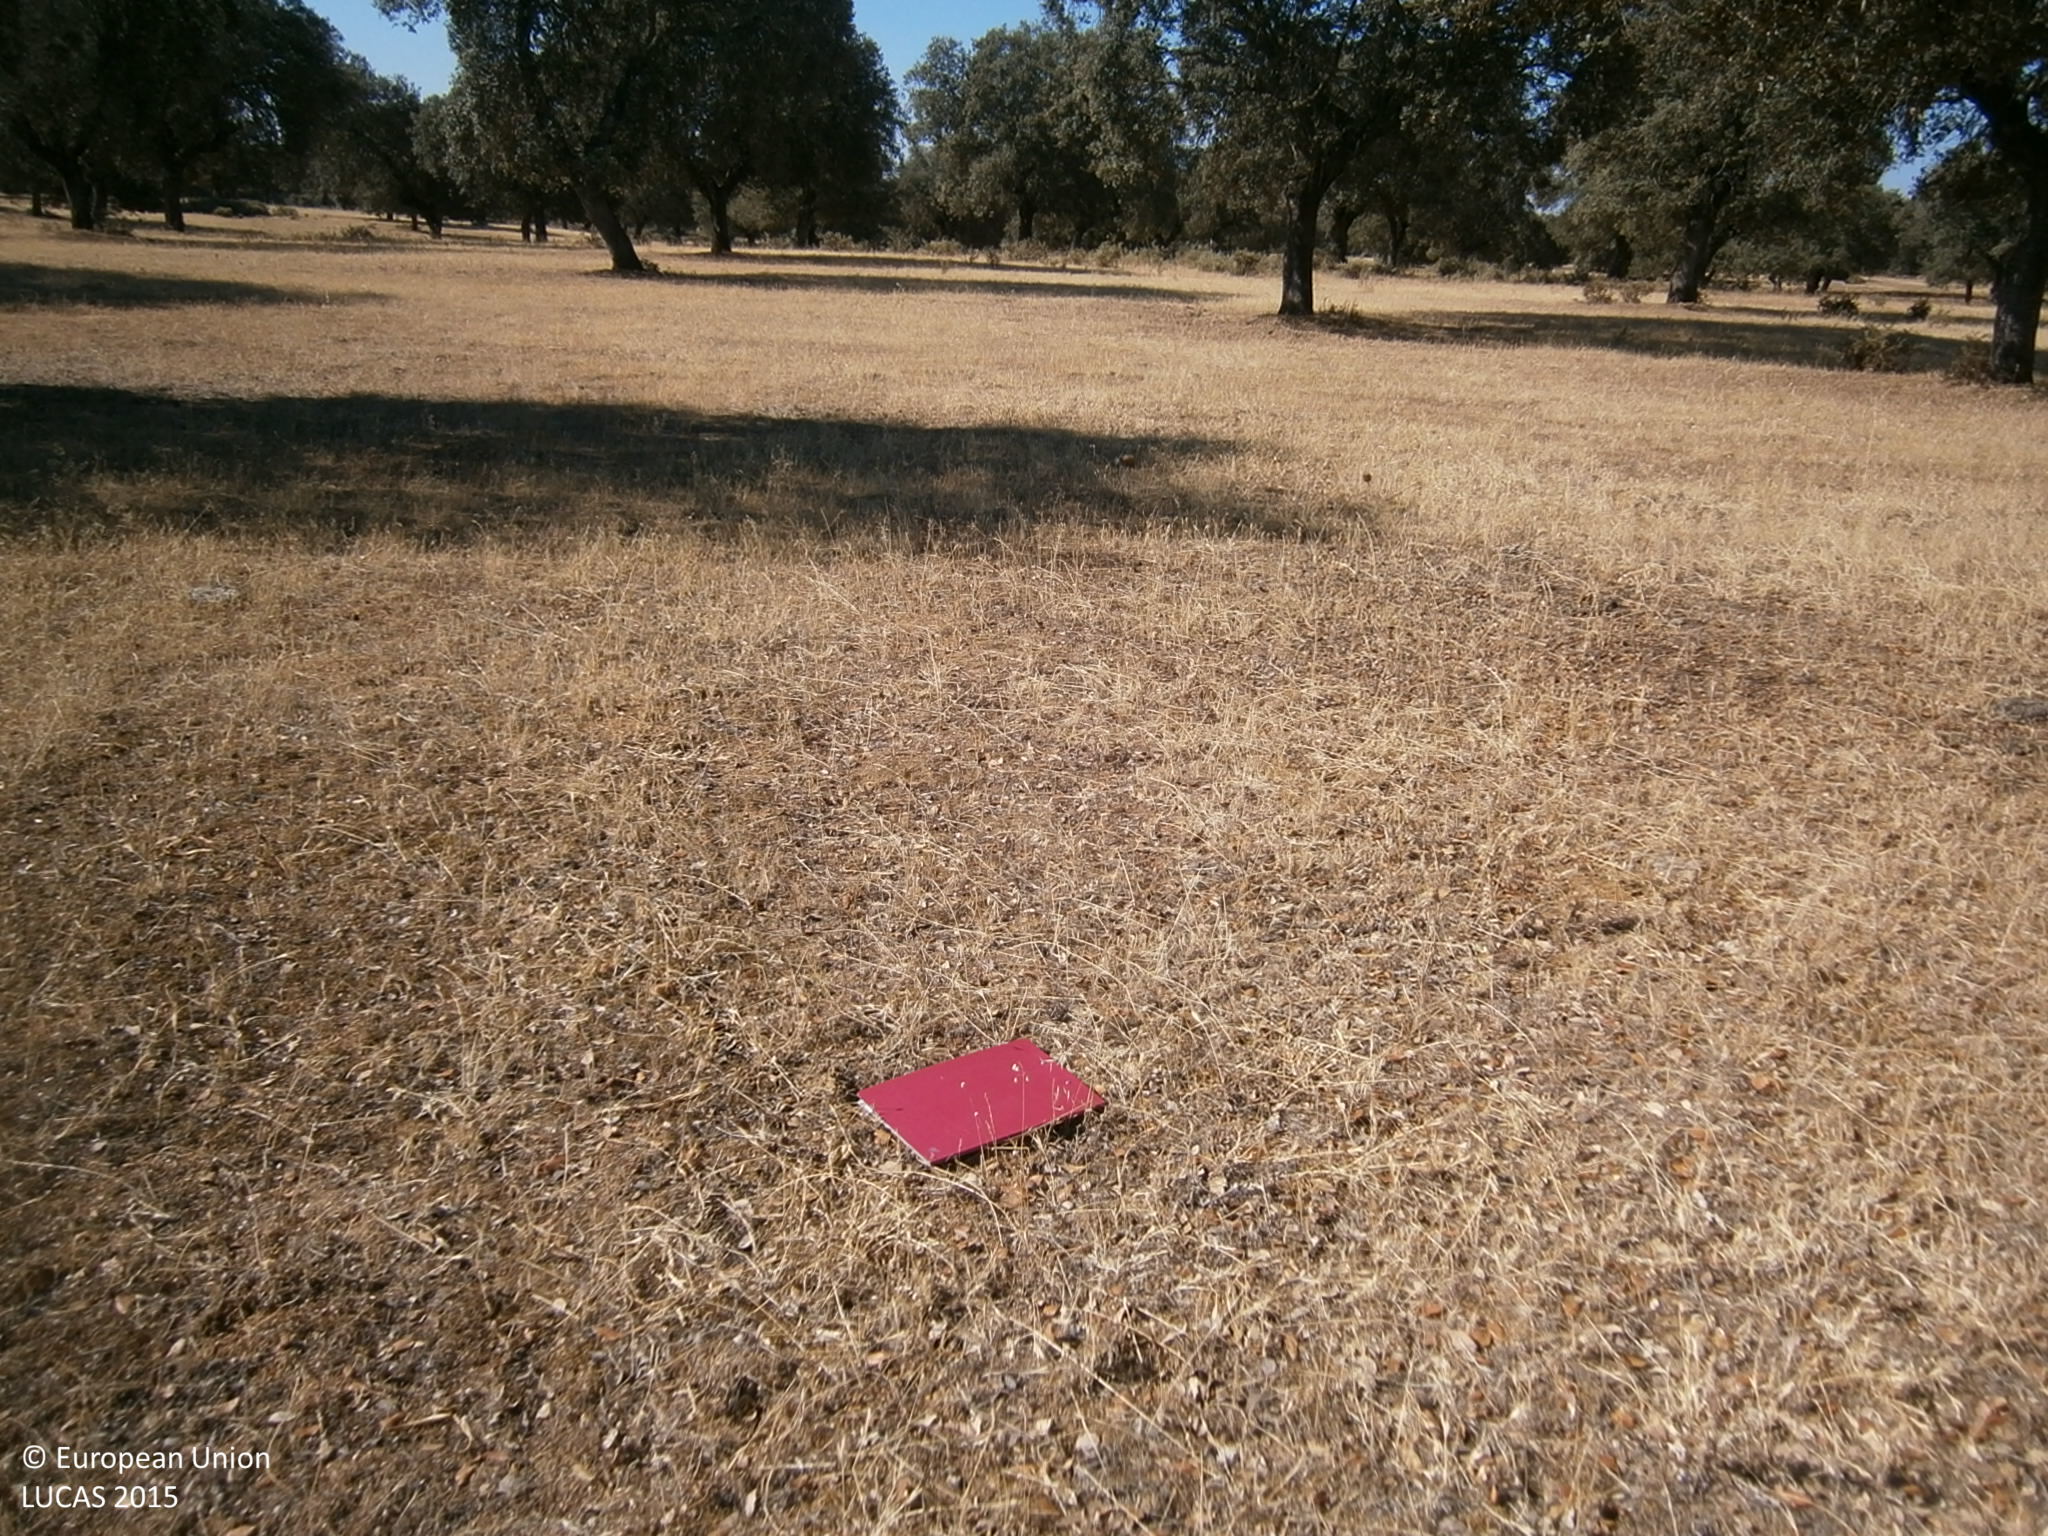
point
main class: Woodland
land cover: Broadleaved woodland
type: broadleaved evergreen forest
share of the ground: 25 - 50 %
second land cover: Spontaneously vegetated surfaces
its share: 50 - 75 %
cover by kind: broadleaved forest trees 40 %, herbaceous plants 40 %, unconsolidated bare surface 20 %
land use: Forestry
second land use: Agriculture (excluding fallow land and kitchen gardens)
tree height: > 5 m
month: July
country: ES
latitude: 38.9741
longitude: -6.7929
